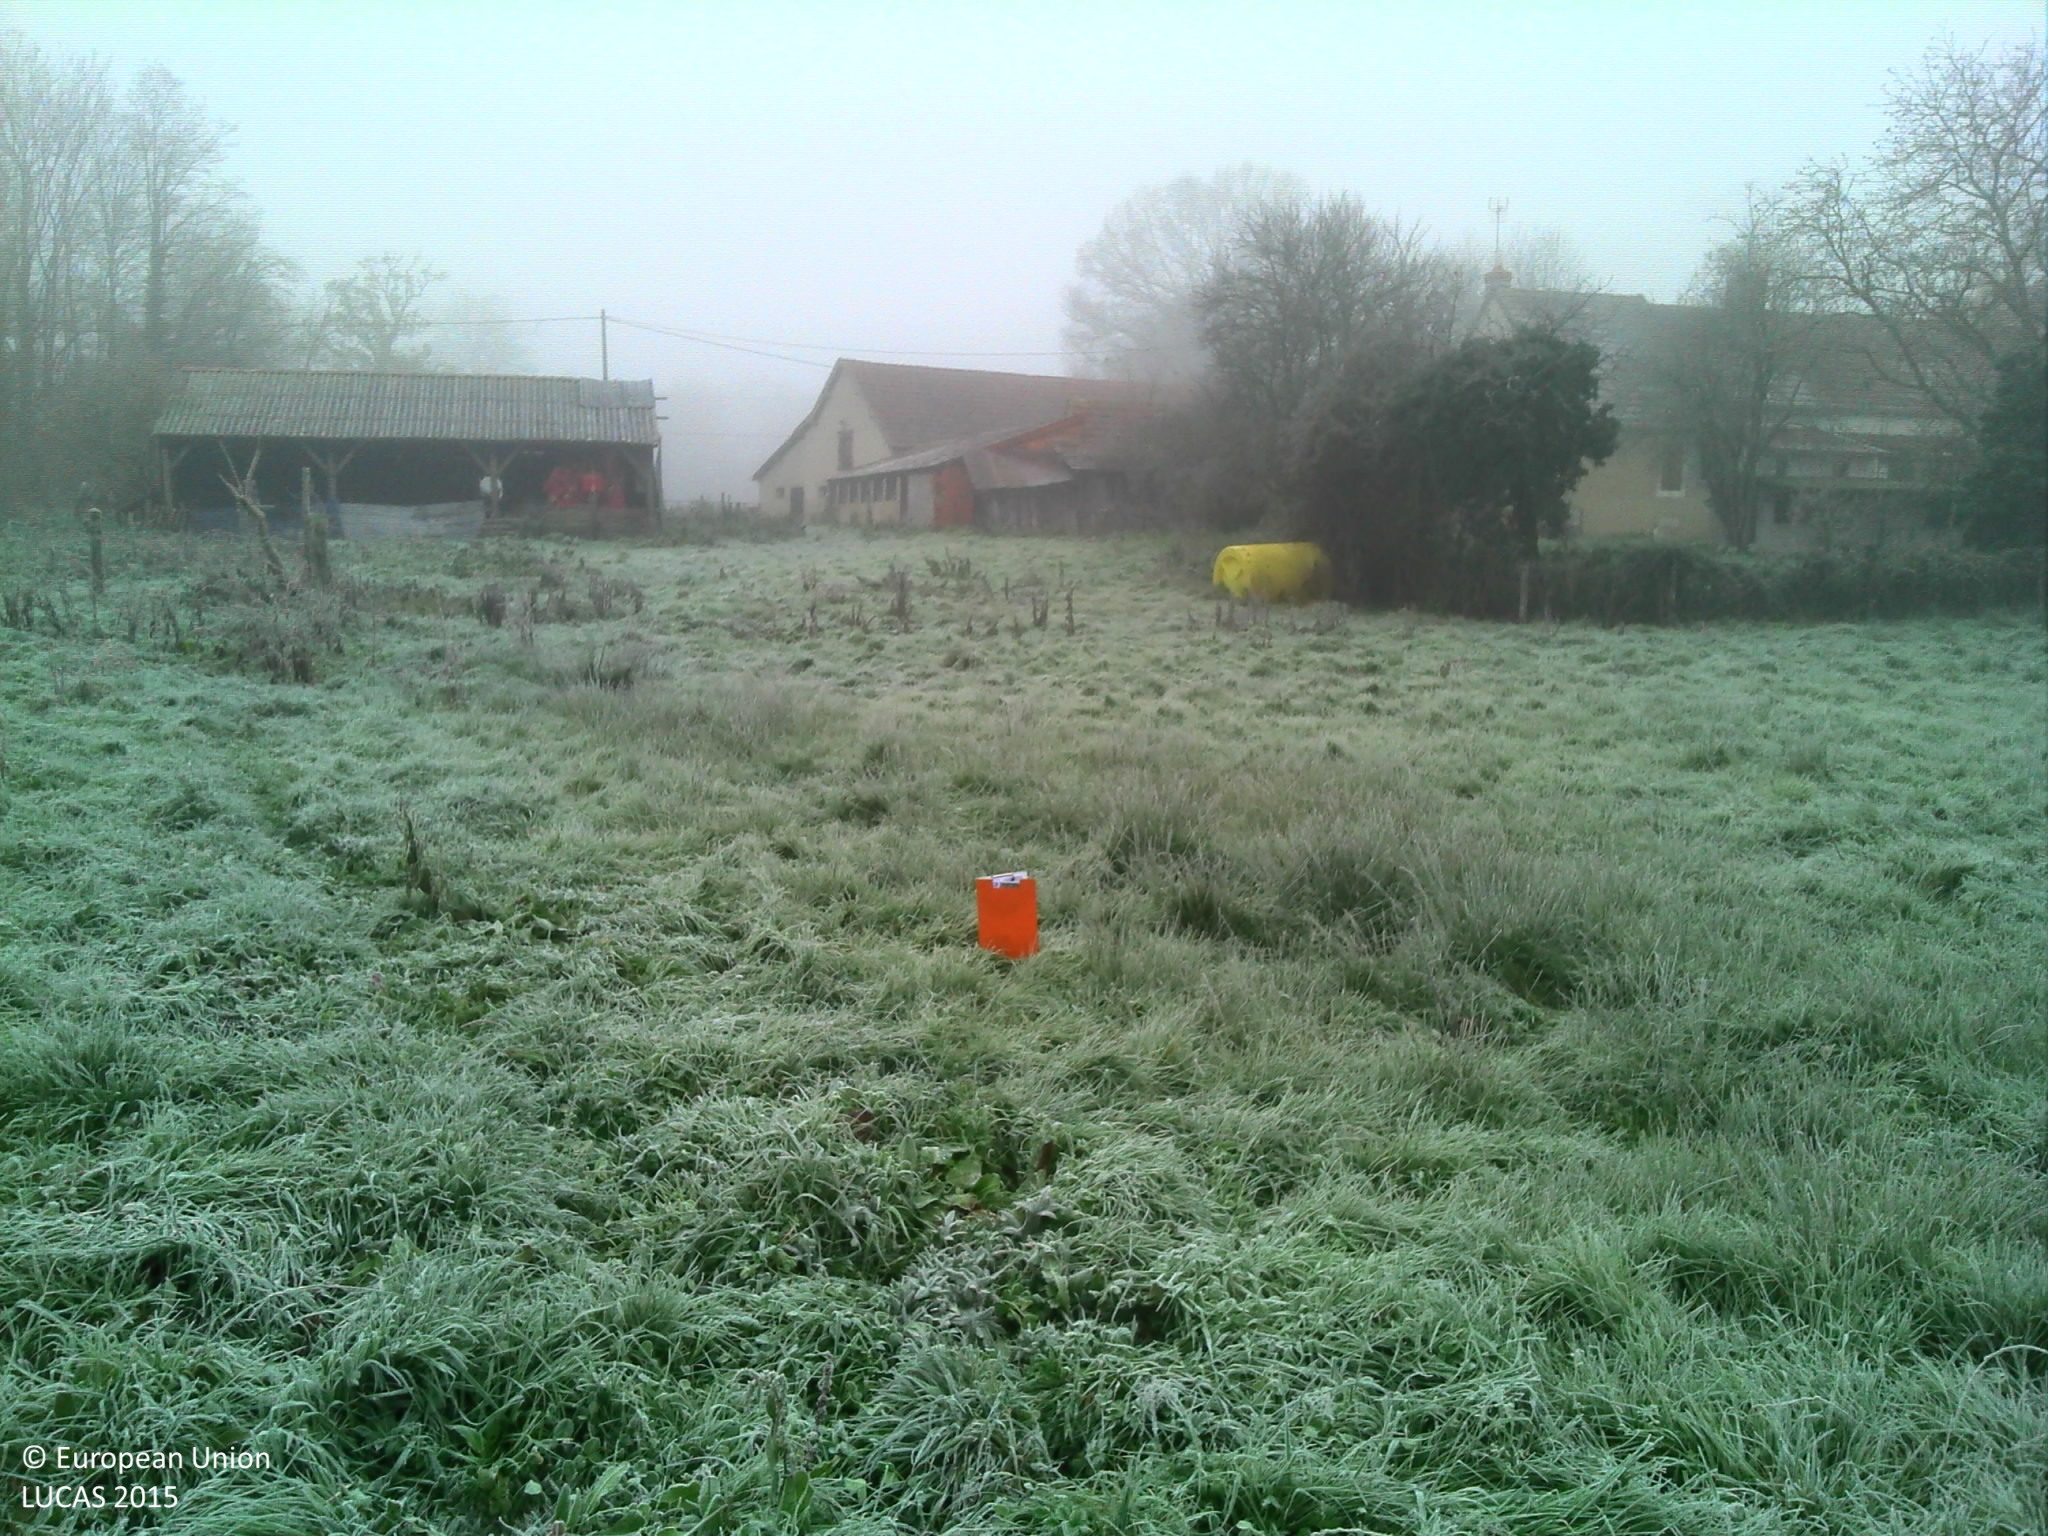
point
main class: Grassland
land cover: Grassland without tree/shrub cover
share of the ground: > 75 %
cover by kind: herbaceous plants 100 %
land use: Agriculture (excluding fallow land and kitchen gardens)
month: November
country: FR
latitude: 46.5792
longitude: 3.6703
